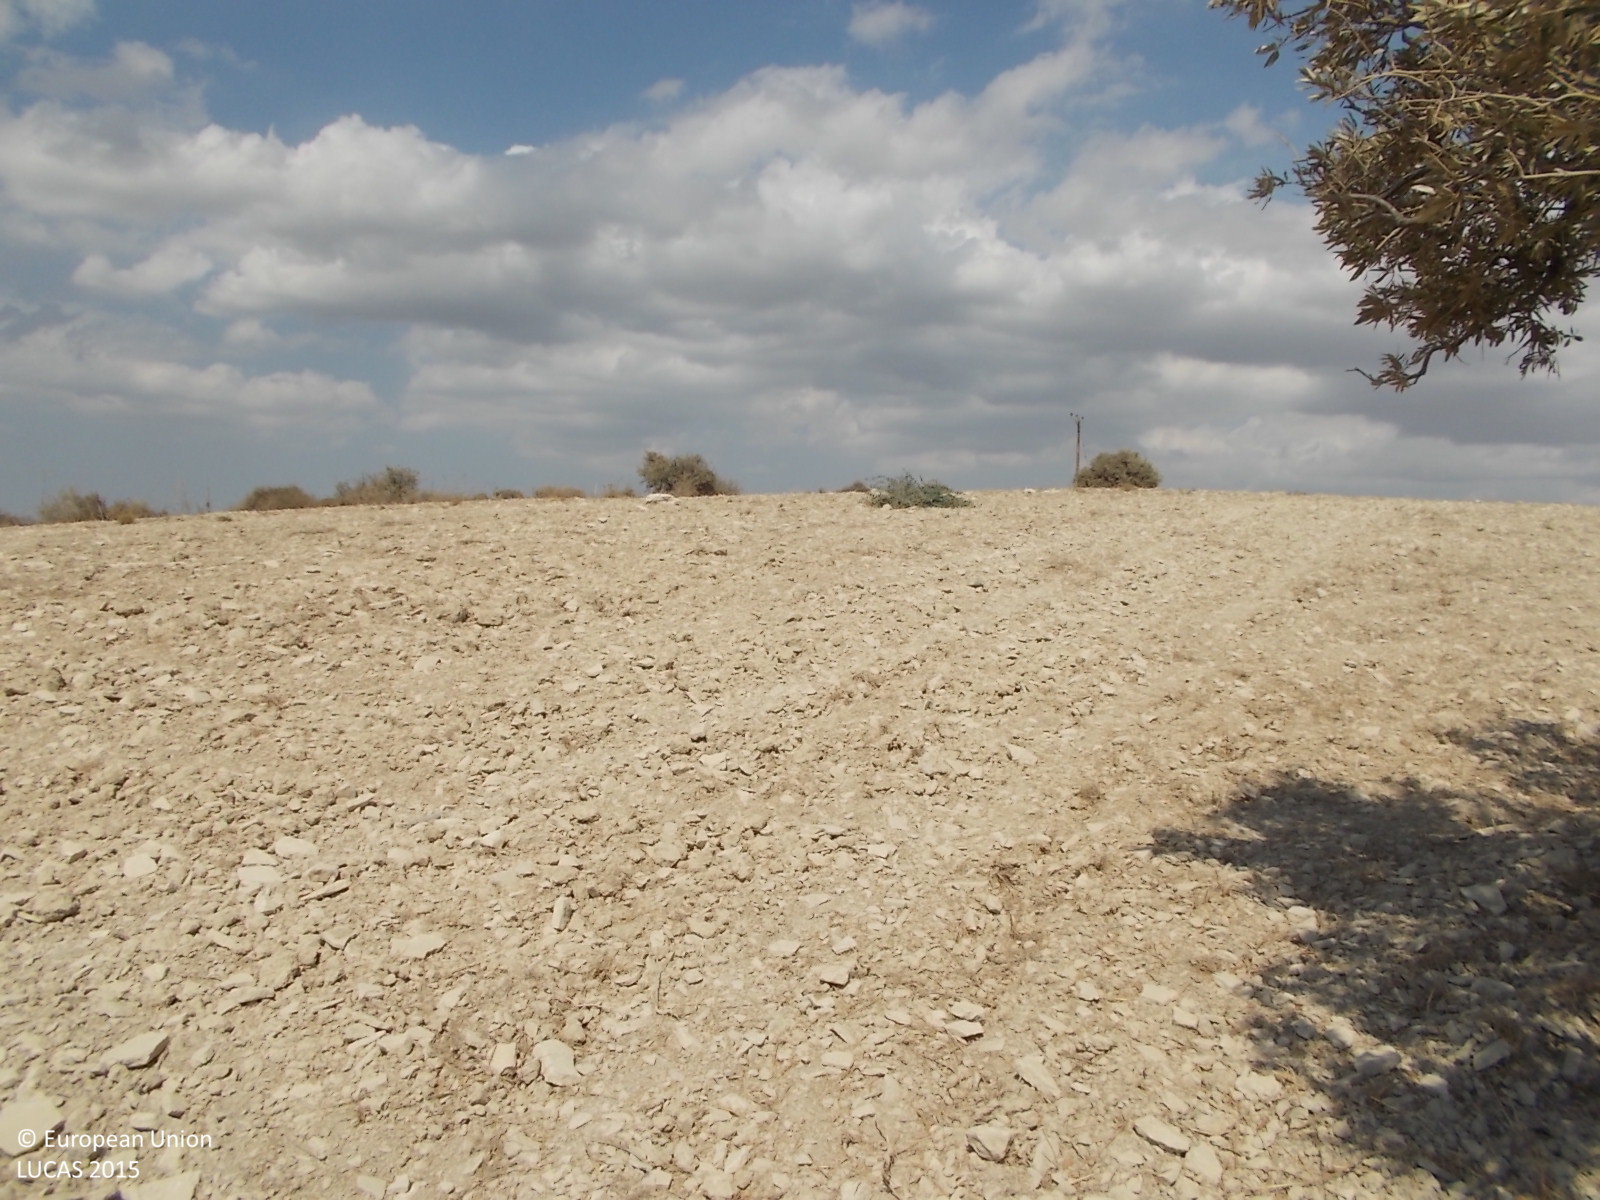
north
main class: Cropland
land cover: Olive groves
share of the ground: < 10 %
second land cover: Other bare soil
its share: > 75 %
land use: Agriculture (excluding fallow land and kitchen gardens)
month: April
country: CY
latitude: 34.8124
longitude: 33.4370
